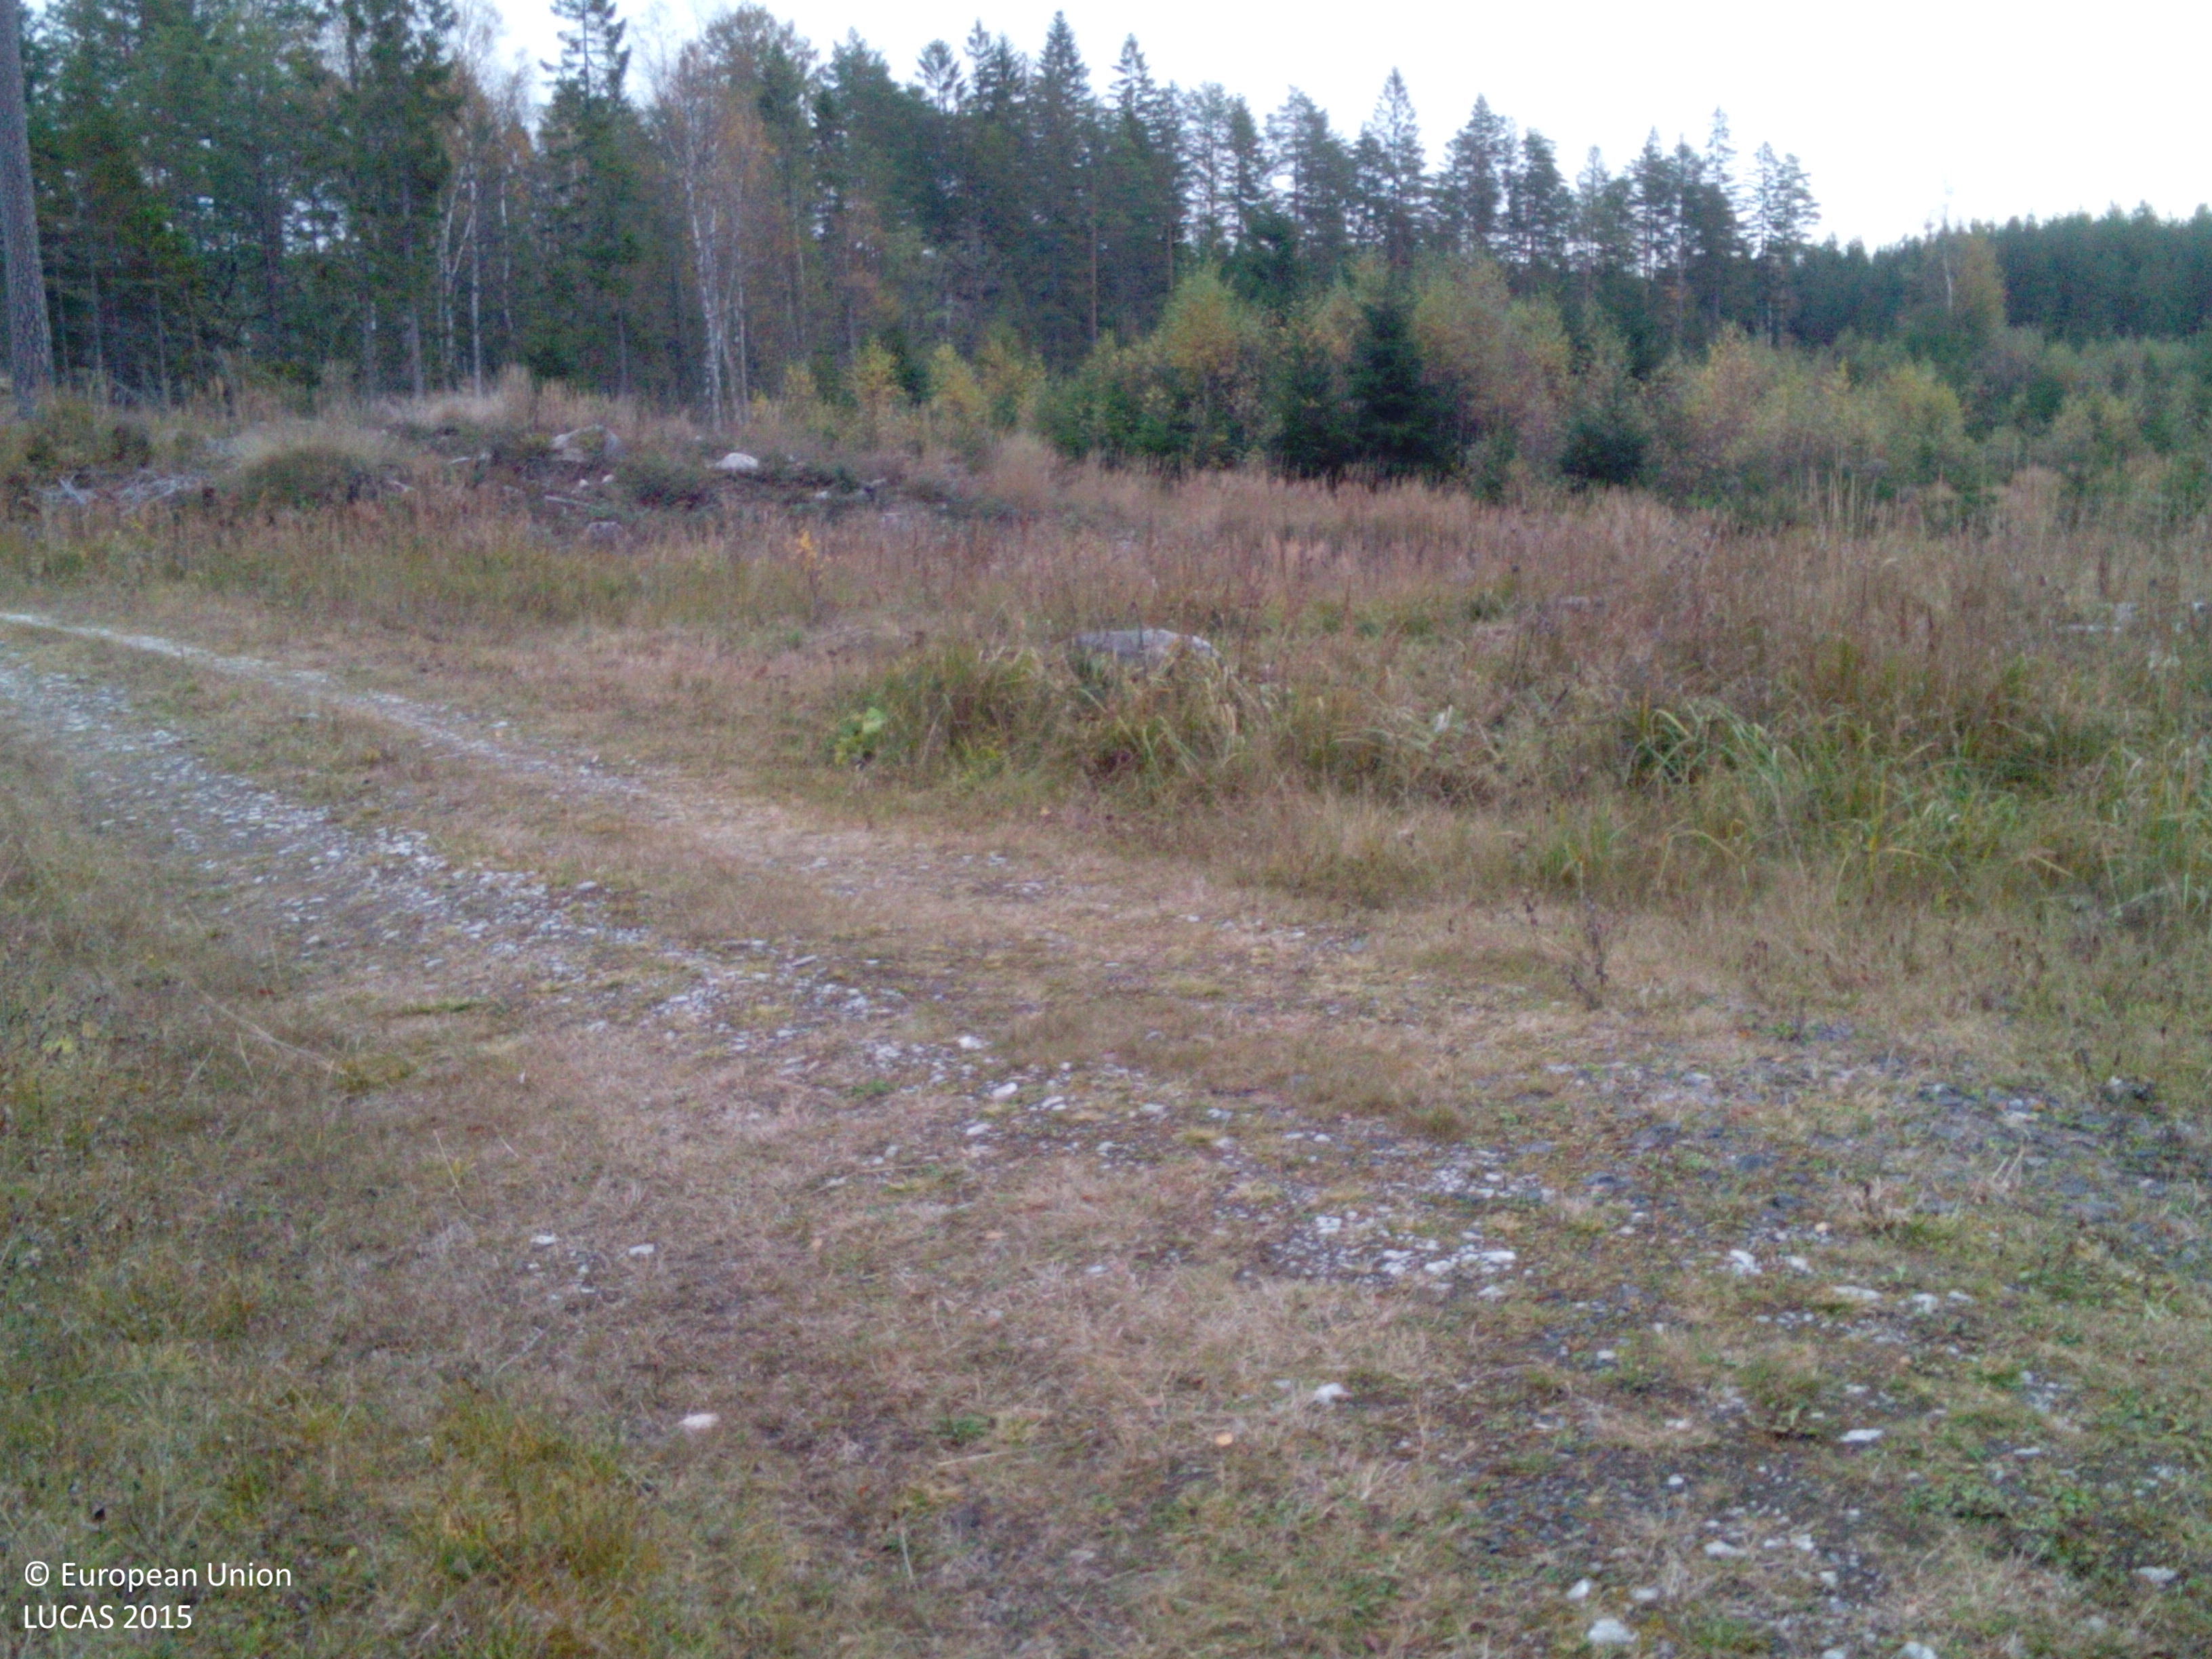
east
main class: Grassland
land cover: Grassland without tree/shrub cover
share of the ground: > 75 %
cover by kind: herbaceous plants 100 %
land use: Semi-natural and natural areas not in use
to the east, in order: Grassland without tree/shrub cover; Spruce dominated coniferous woodland; Spruce dominated mixed woodland; Spontaneously vegetated surfaces; Inland marshes; Spruce dominated mixed woodland
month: October
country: SE
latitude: 58.8081
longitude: 16.3826
